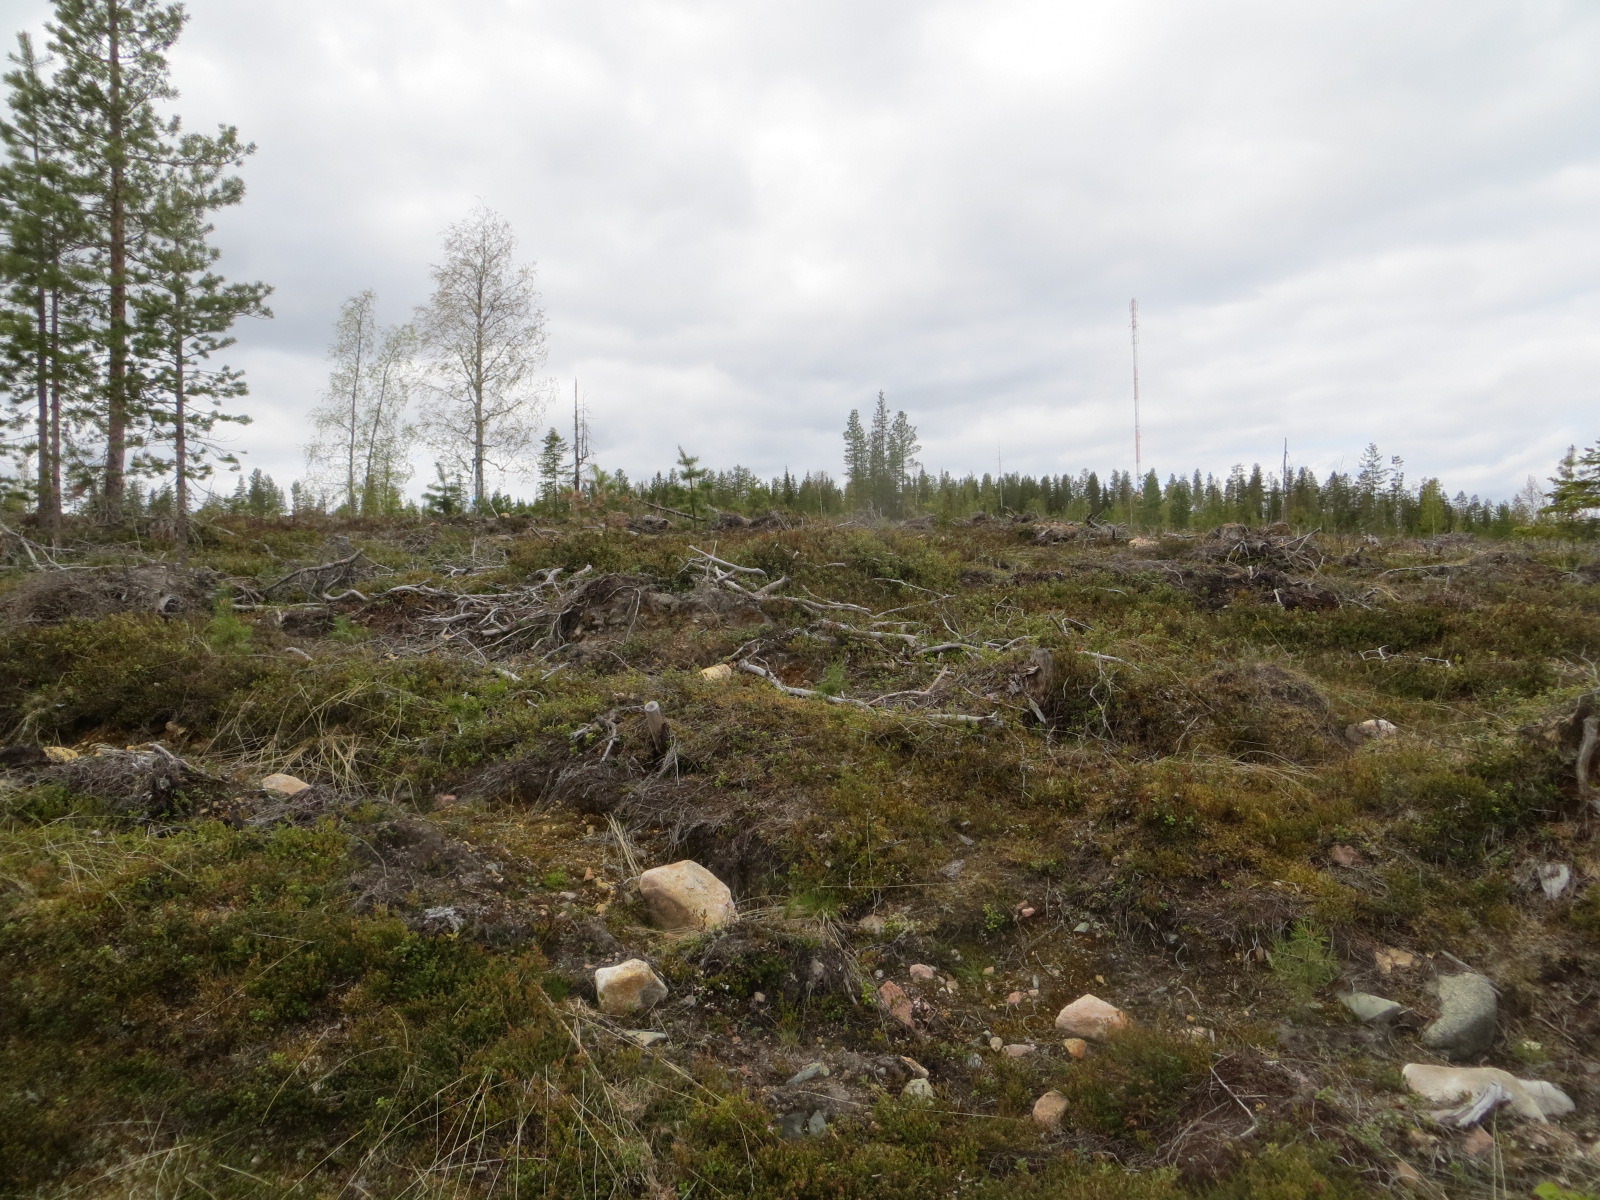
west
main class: Shrubland
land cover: Shrubland with sparse tree cover
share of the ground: > 75 %
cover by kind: shrubs 70 %, herbaceous plants 10 %, unconsolidated bare surface 10 %, coniferous forest trees 5 %, lichens and mosses 5 %
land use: Forestry
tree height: < 5 m
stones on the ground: 25 - 50 %
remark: Clear cut
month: June
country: FI
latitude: 67.6072
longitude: 24.9262
